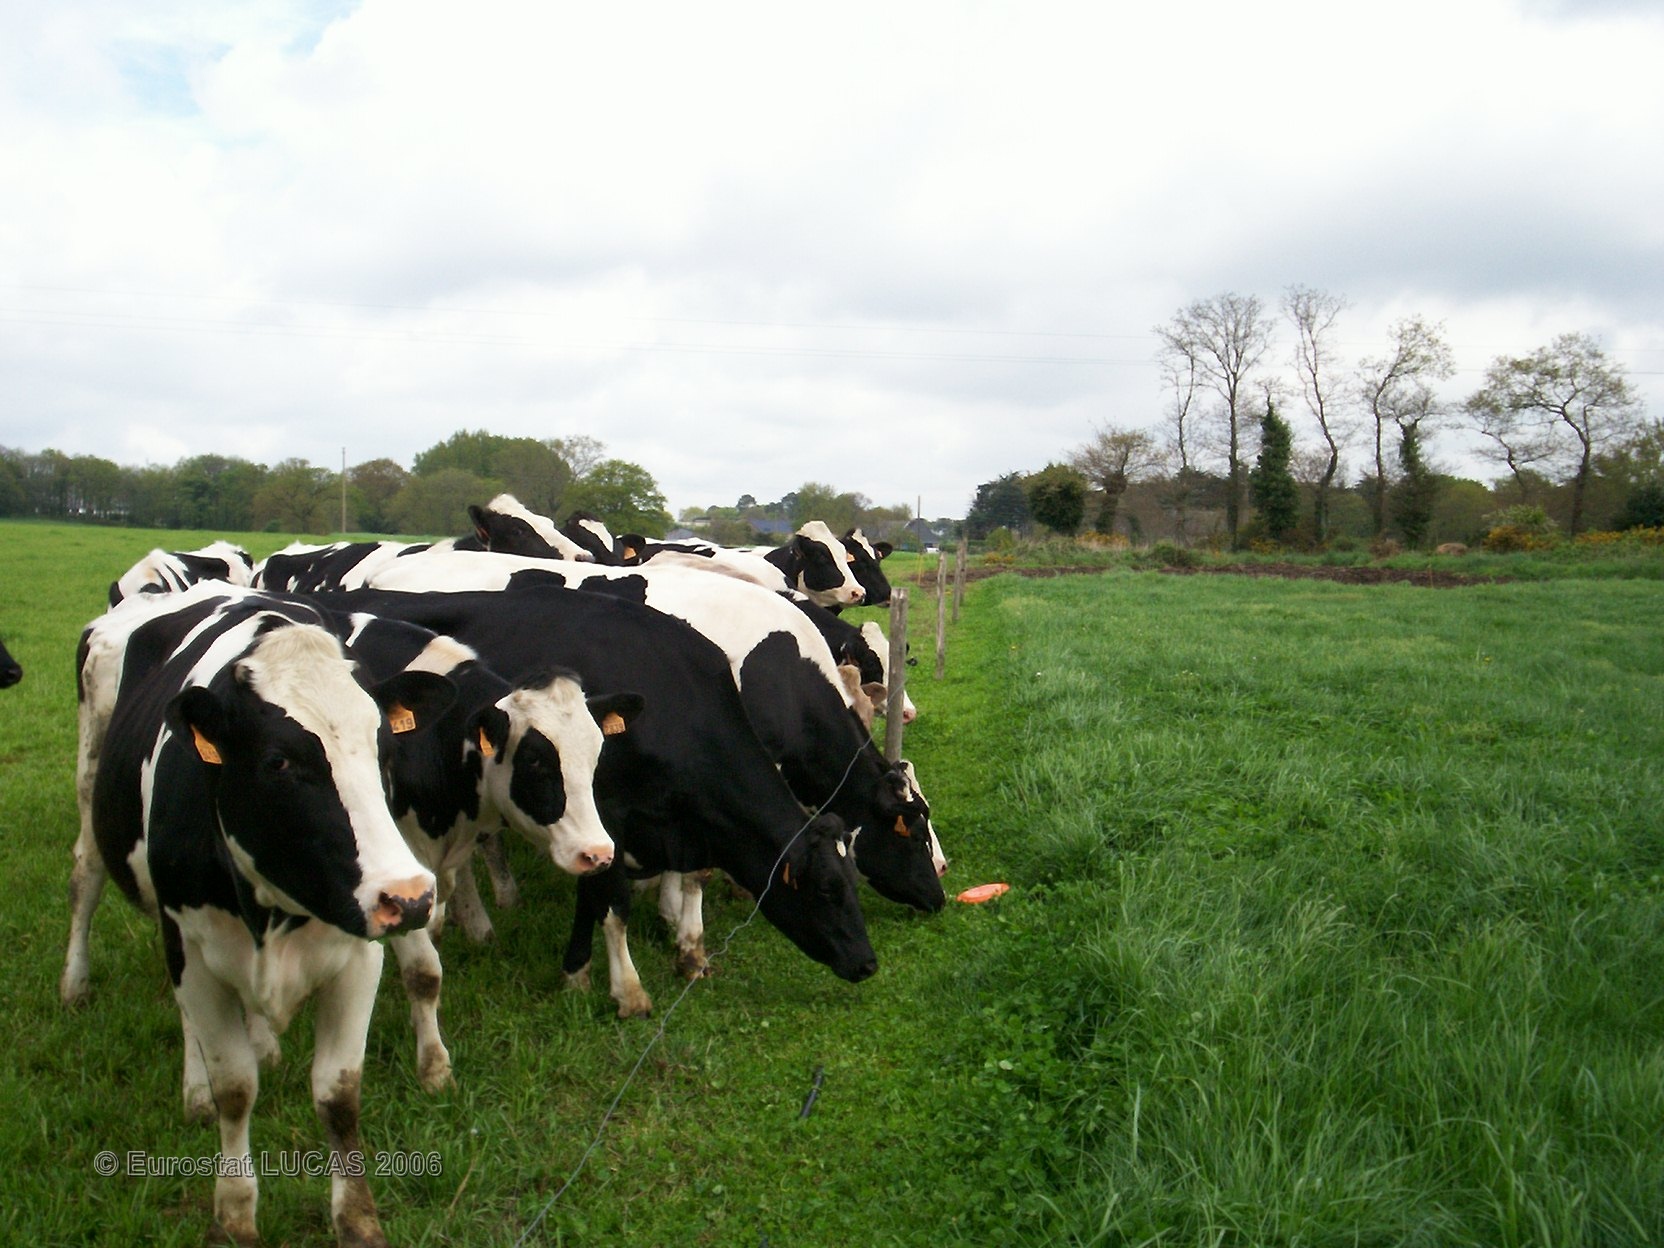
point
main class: Grassland
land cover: Grassland without tree/shrub cover
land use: Agriculture (excluding fallow land and kitchen gardens)
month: May
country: FR
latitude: 47.6531
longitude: -2.6687
